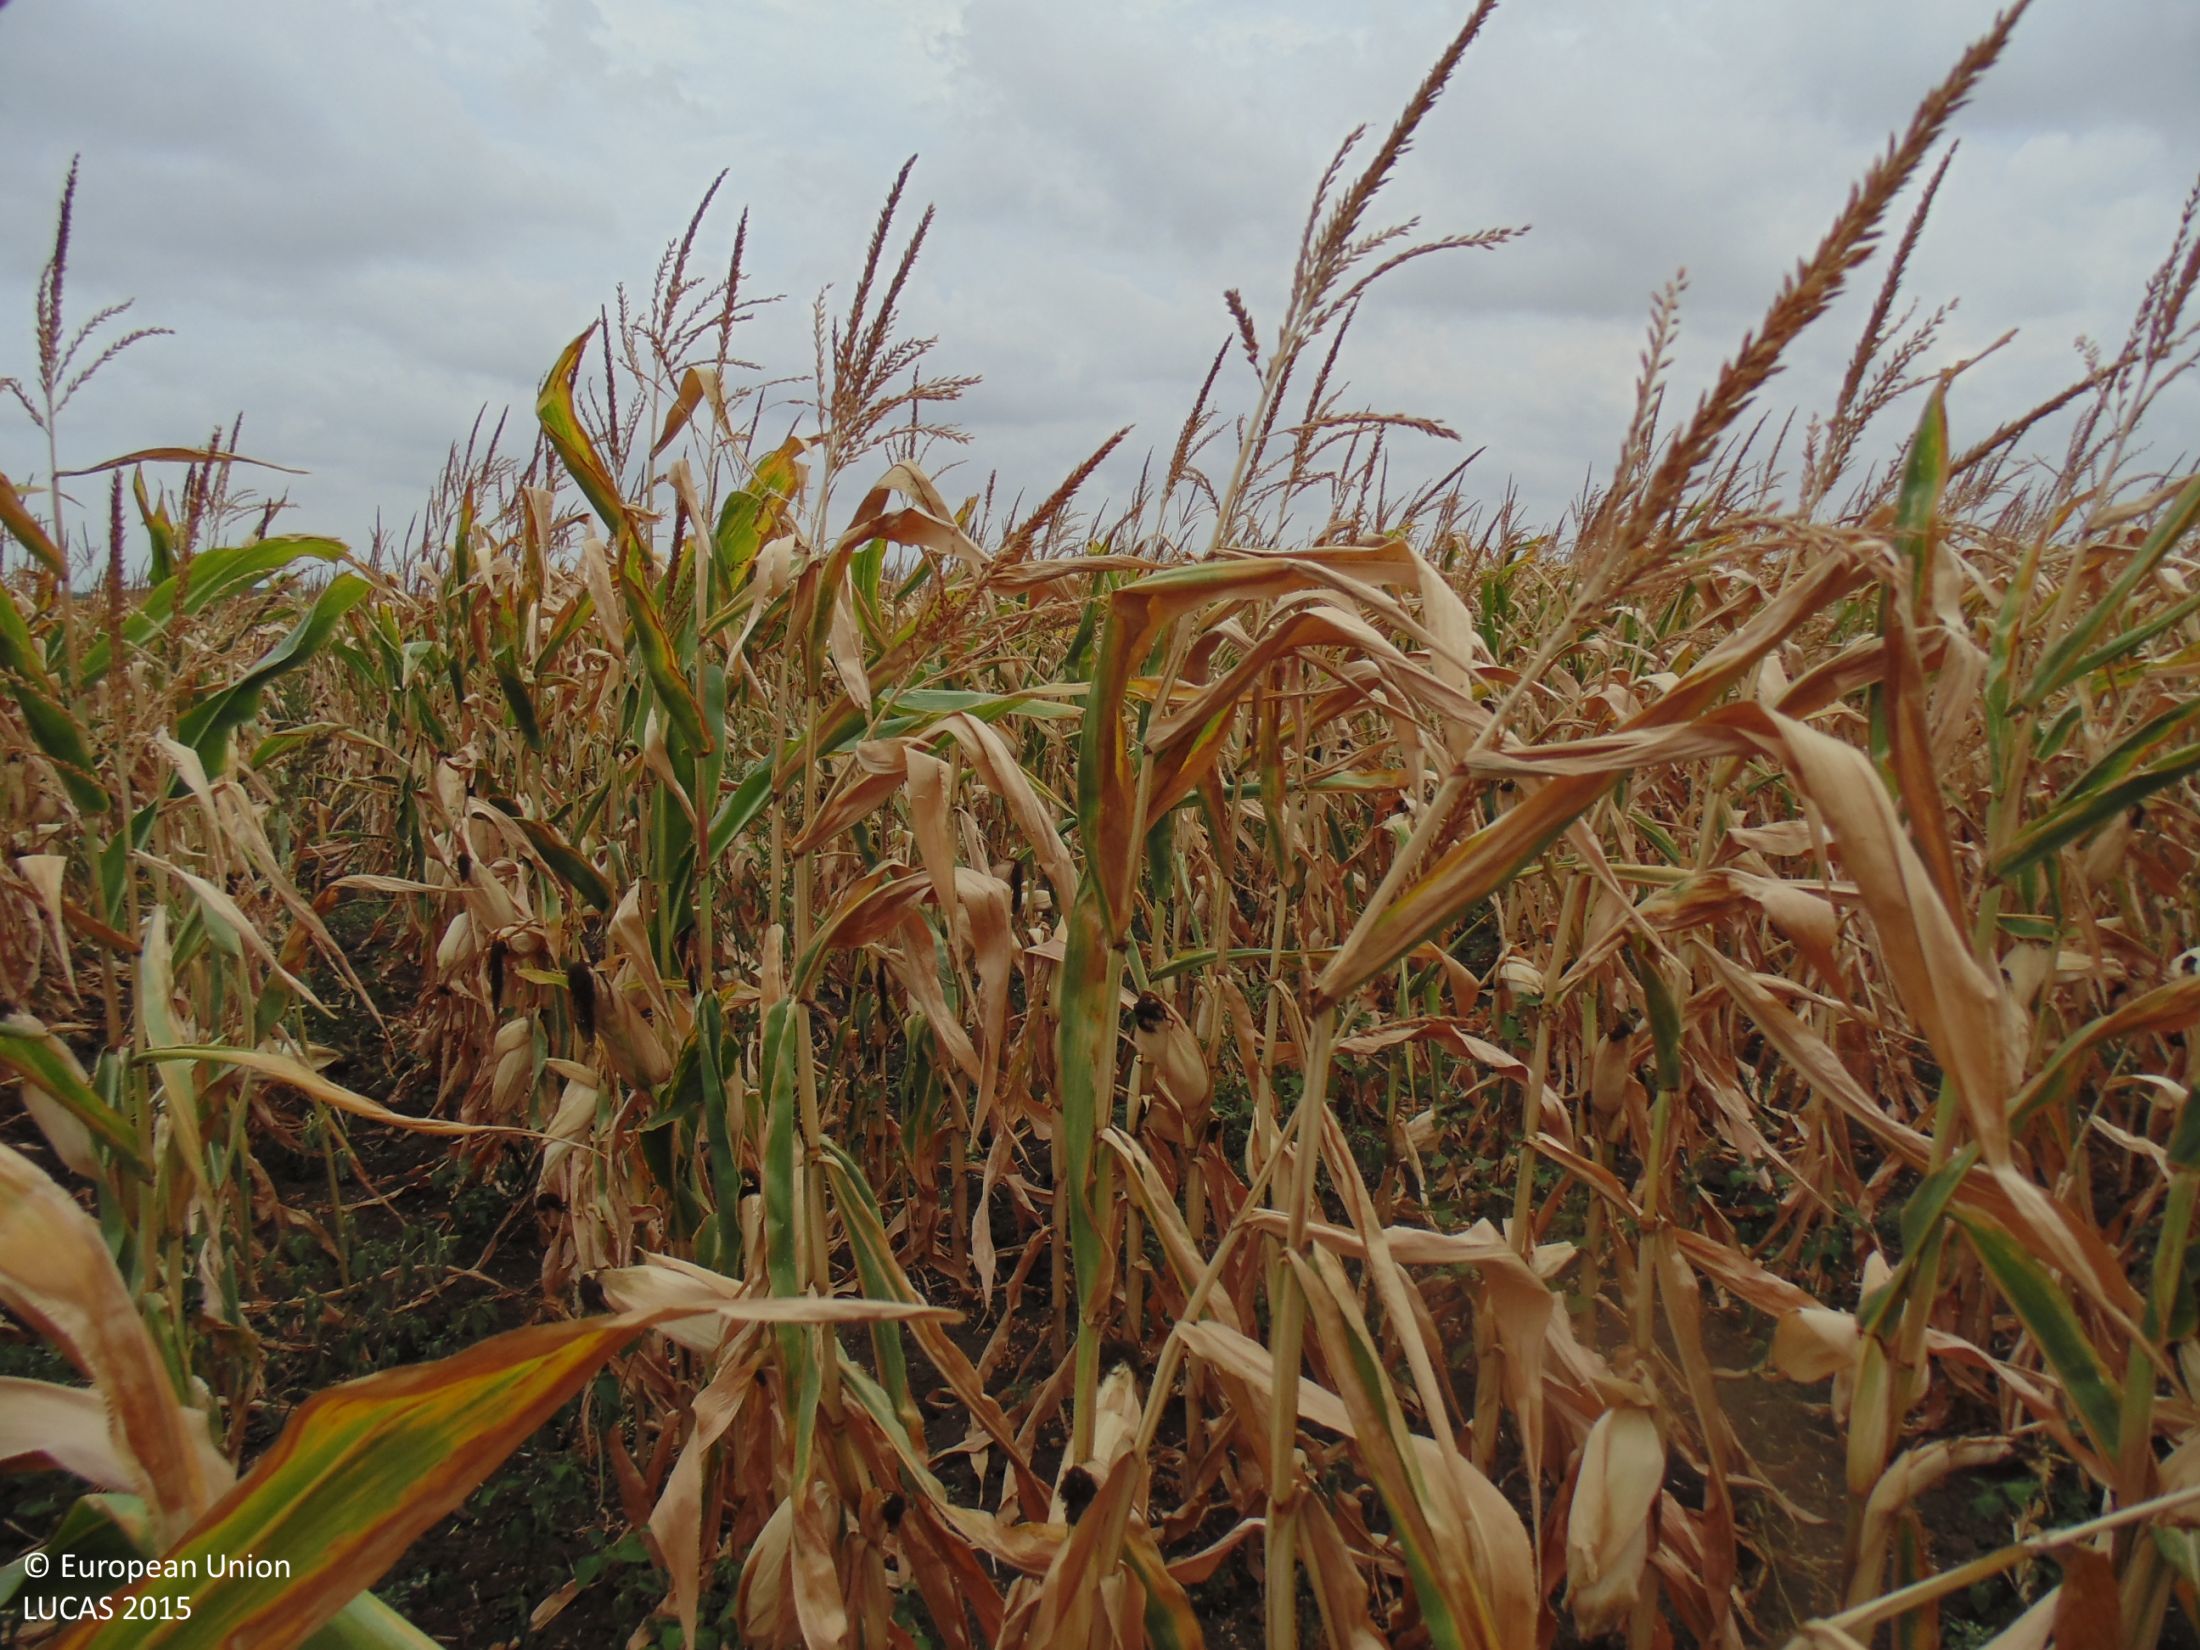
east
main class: Cropland
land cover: Maize
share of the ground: > 75 %
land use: Agriculture (excluding fallow land and kitchen gardens)
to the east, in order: Maize
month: August
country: BG
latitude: 43.5261
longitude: 28.4595
